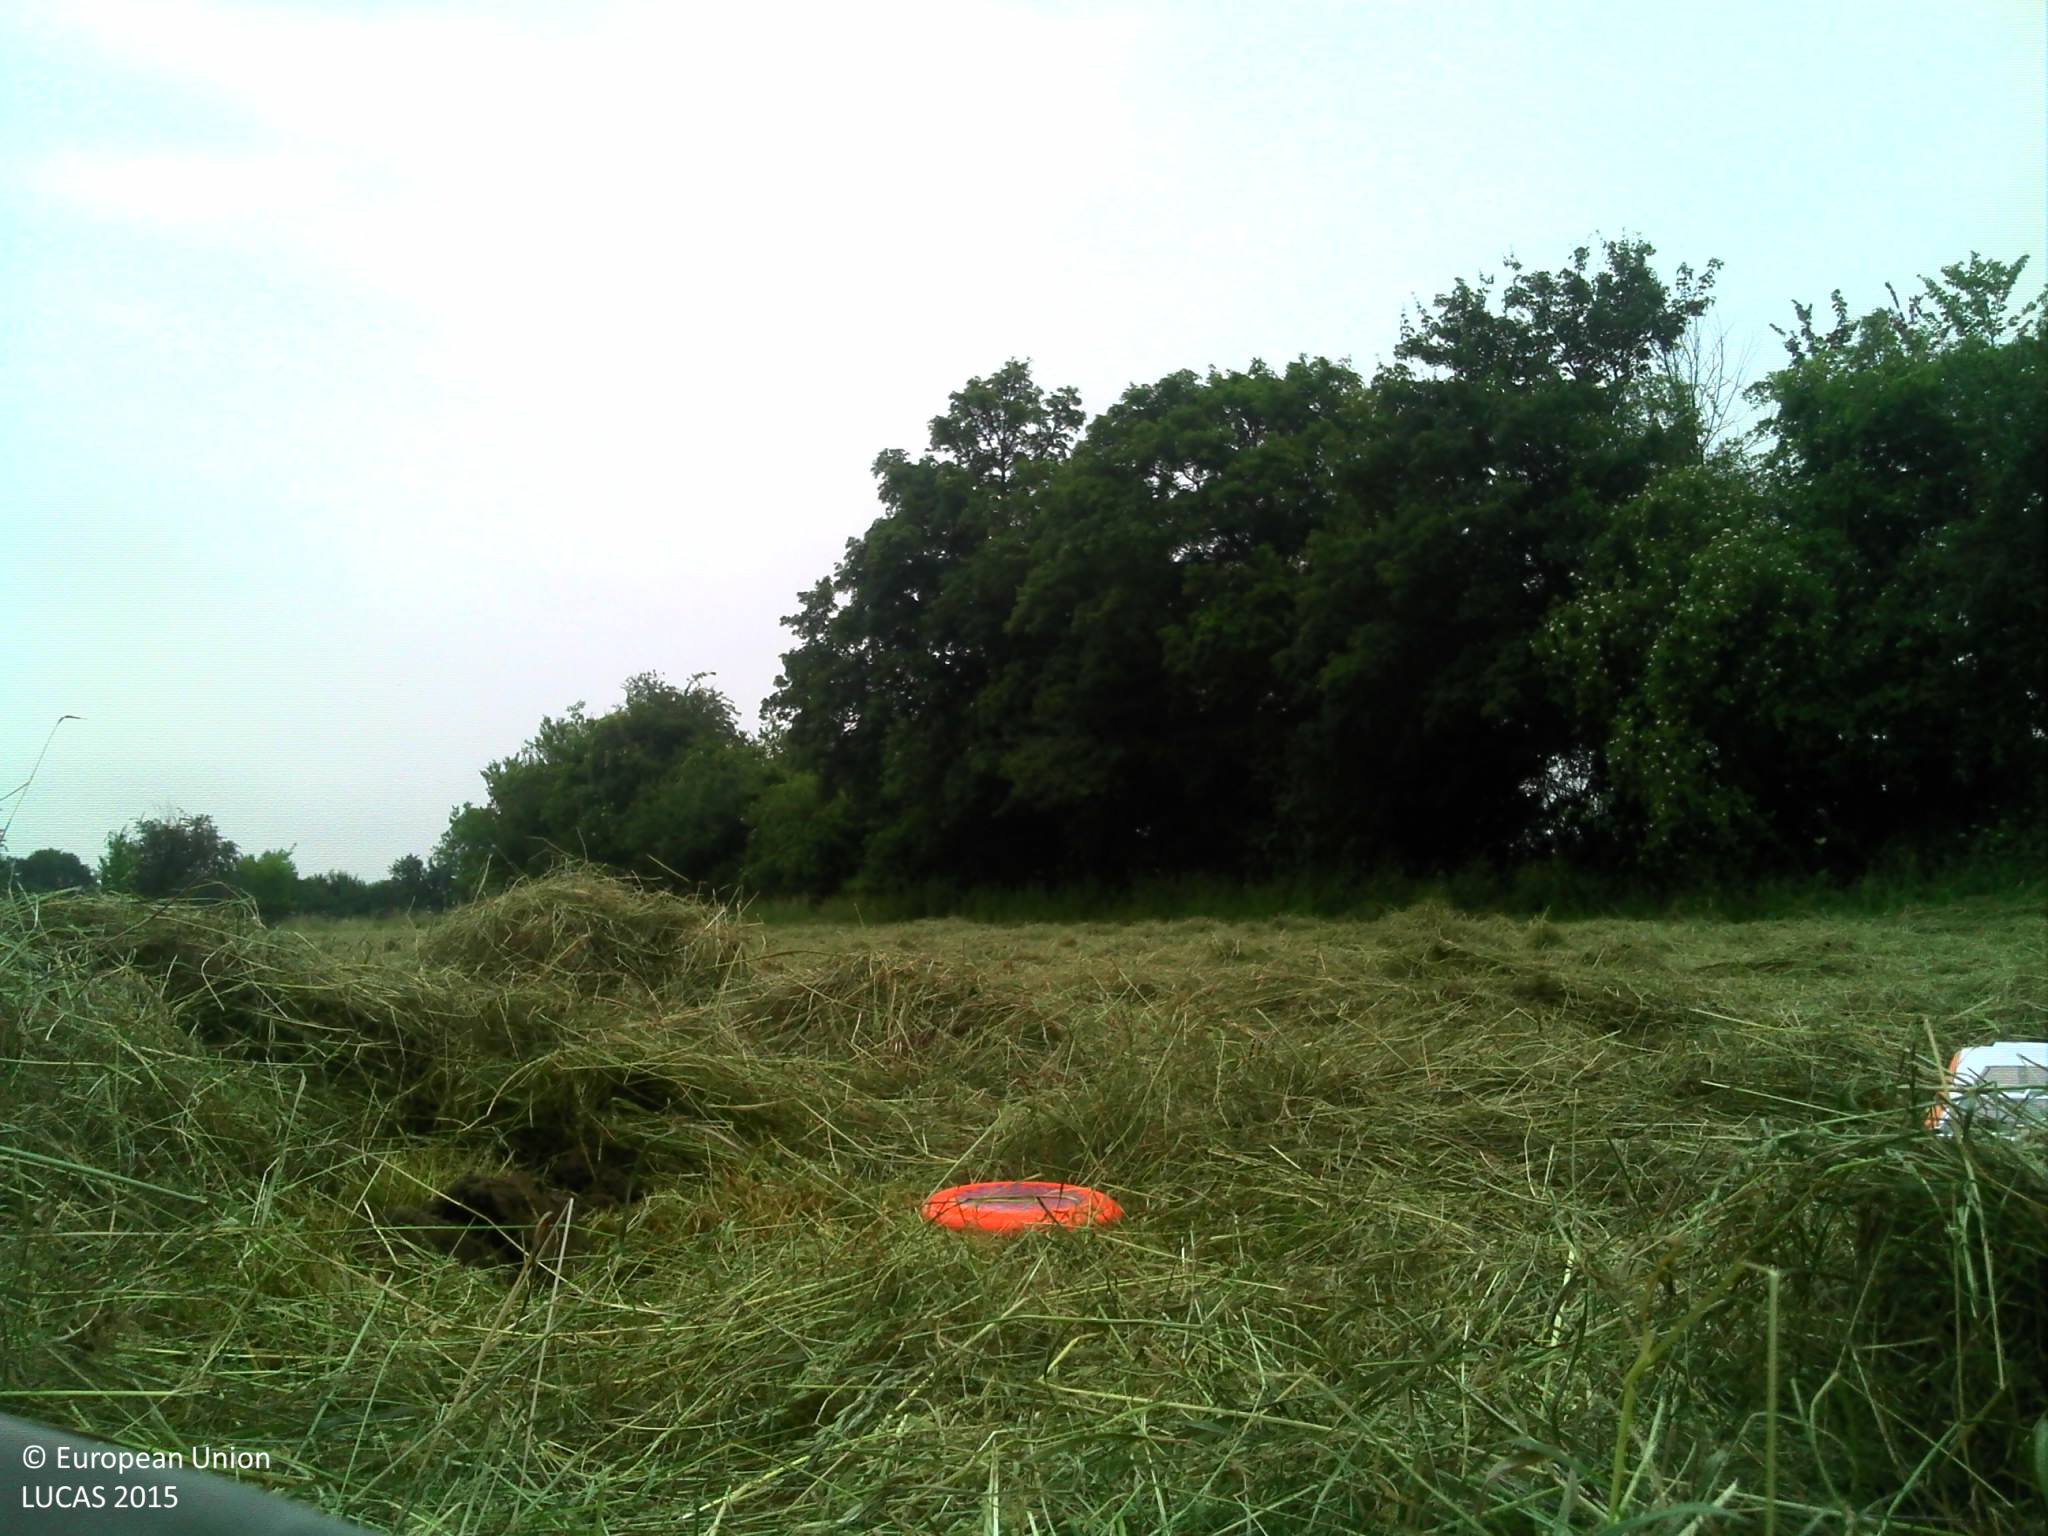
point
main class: Grassland
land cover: Grassland without tree/shrub cover
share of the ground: > 75 %
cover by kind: herbaceous plants 100 %
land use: Agriculture (excluding fallow land and kitchen gardens)
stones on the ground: < 10 %
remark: Harvested field
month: June
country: FR
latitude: 48.7541
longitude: 0.0821
